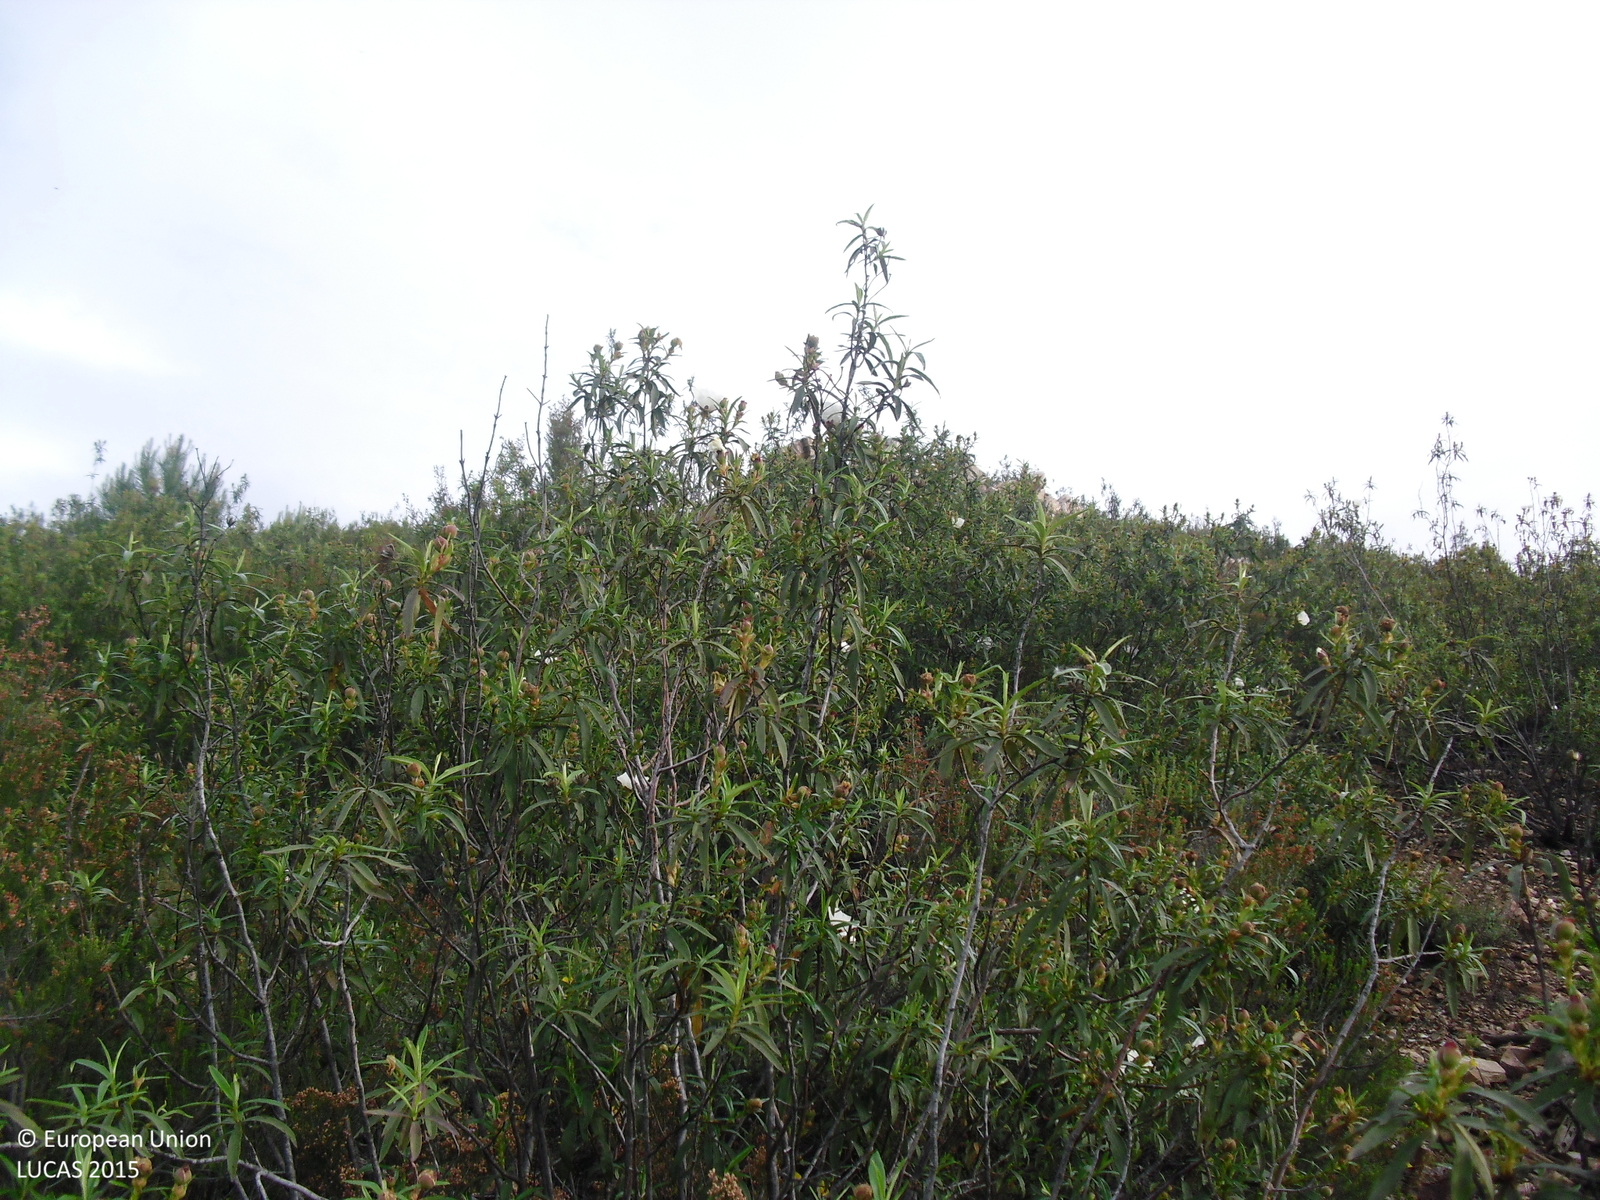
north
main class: Shrubland
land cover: Shrubland with sparse tree cover
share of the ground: > 75 %
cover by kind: shrubs 80 %, unconsolidated bare surface 15 %, broadleaved forest trees 5 %
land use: Semi-natural and natural areas not in use
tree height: < 5 m
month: May
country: ES
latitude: 39.3806
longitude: -5.3600
